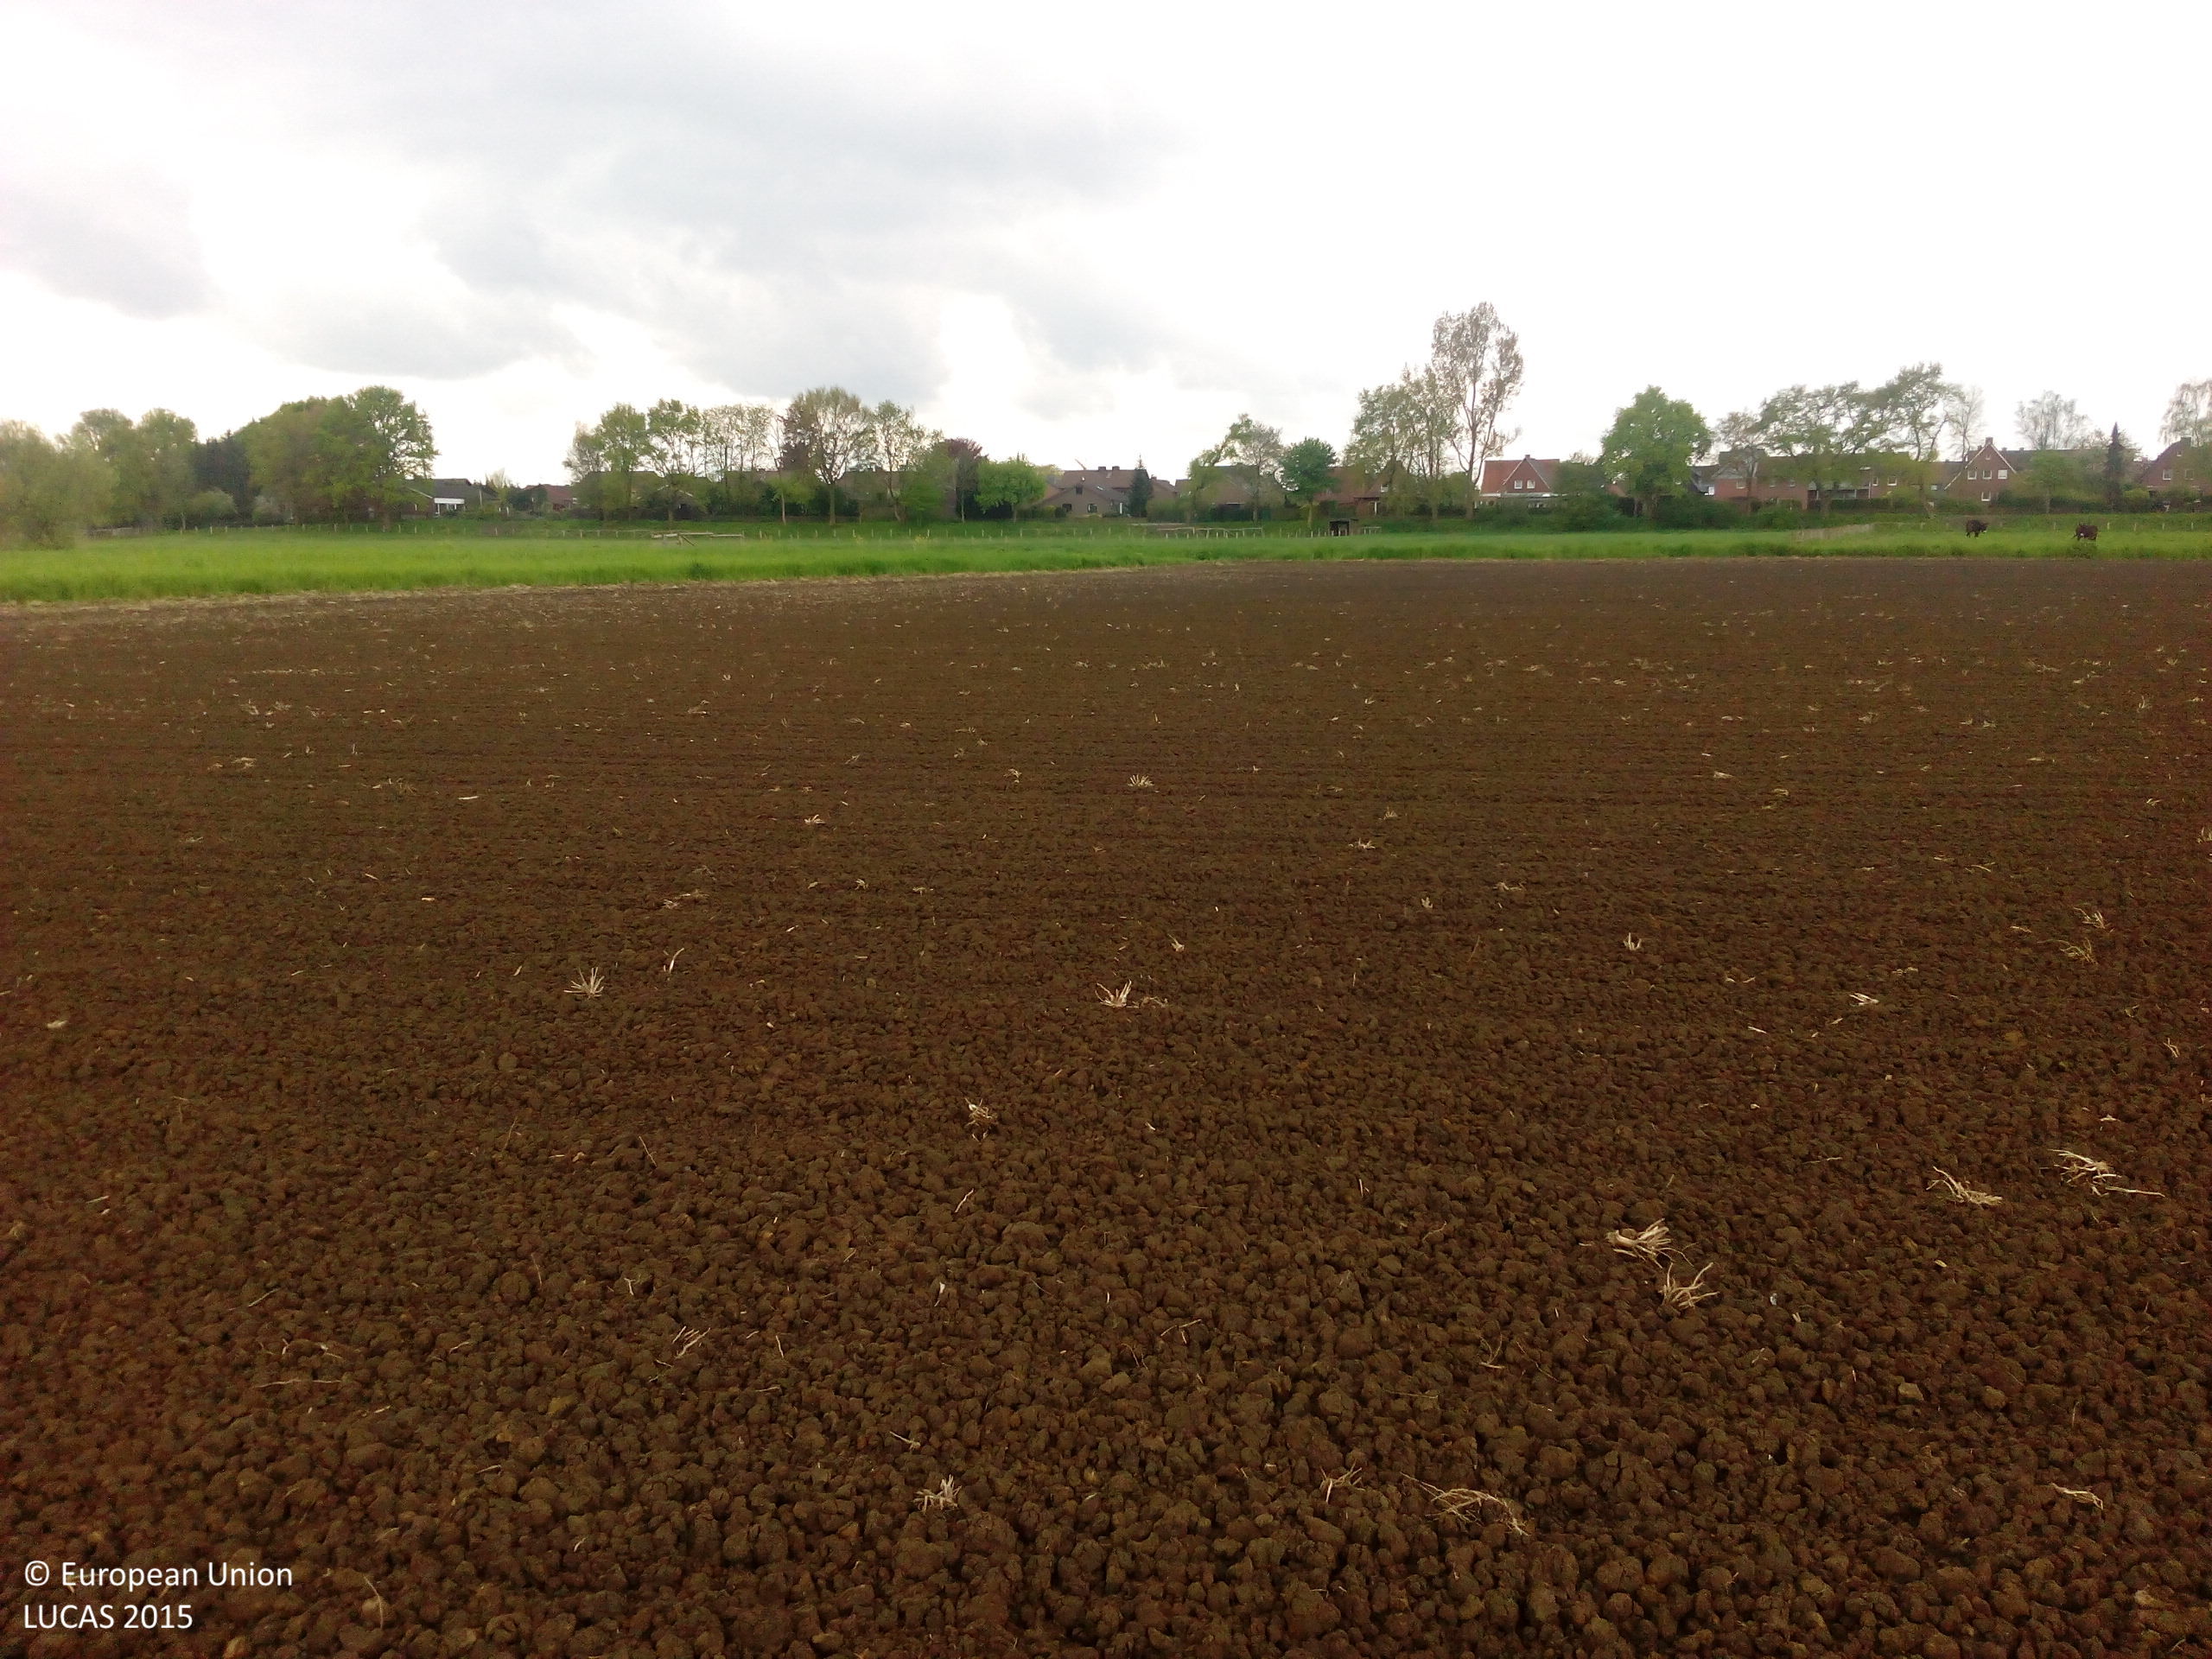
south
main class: Cropland
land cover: Maize
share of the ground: < 10 %
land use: Agriculture (excluding fallow land and kitchen gardens)
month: May
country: DE
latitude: 51.7191
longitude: 7.3802
